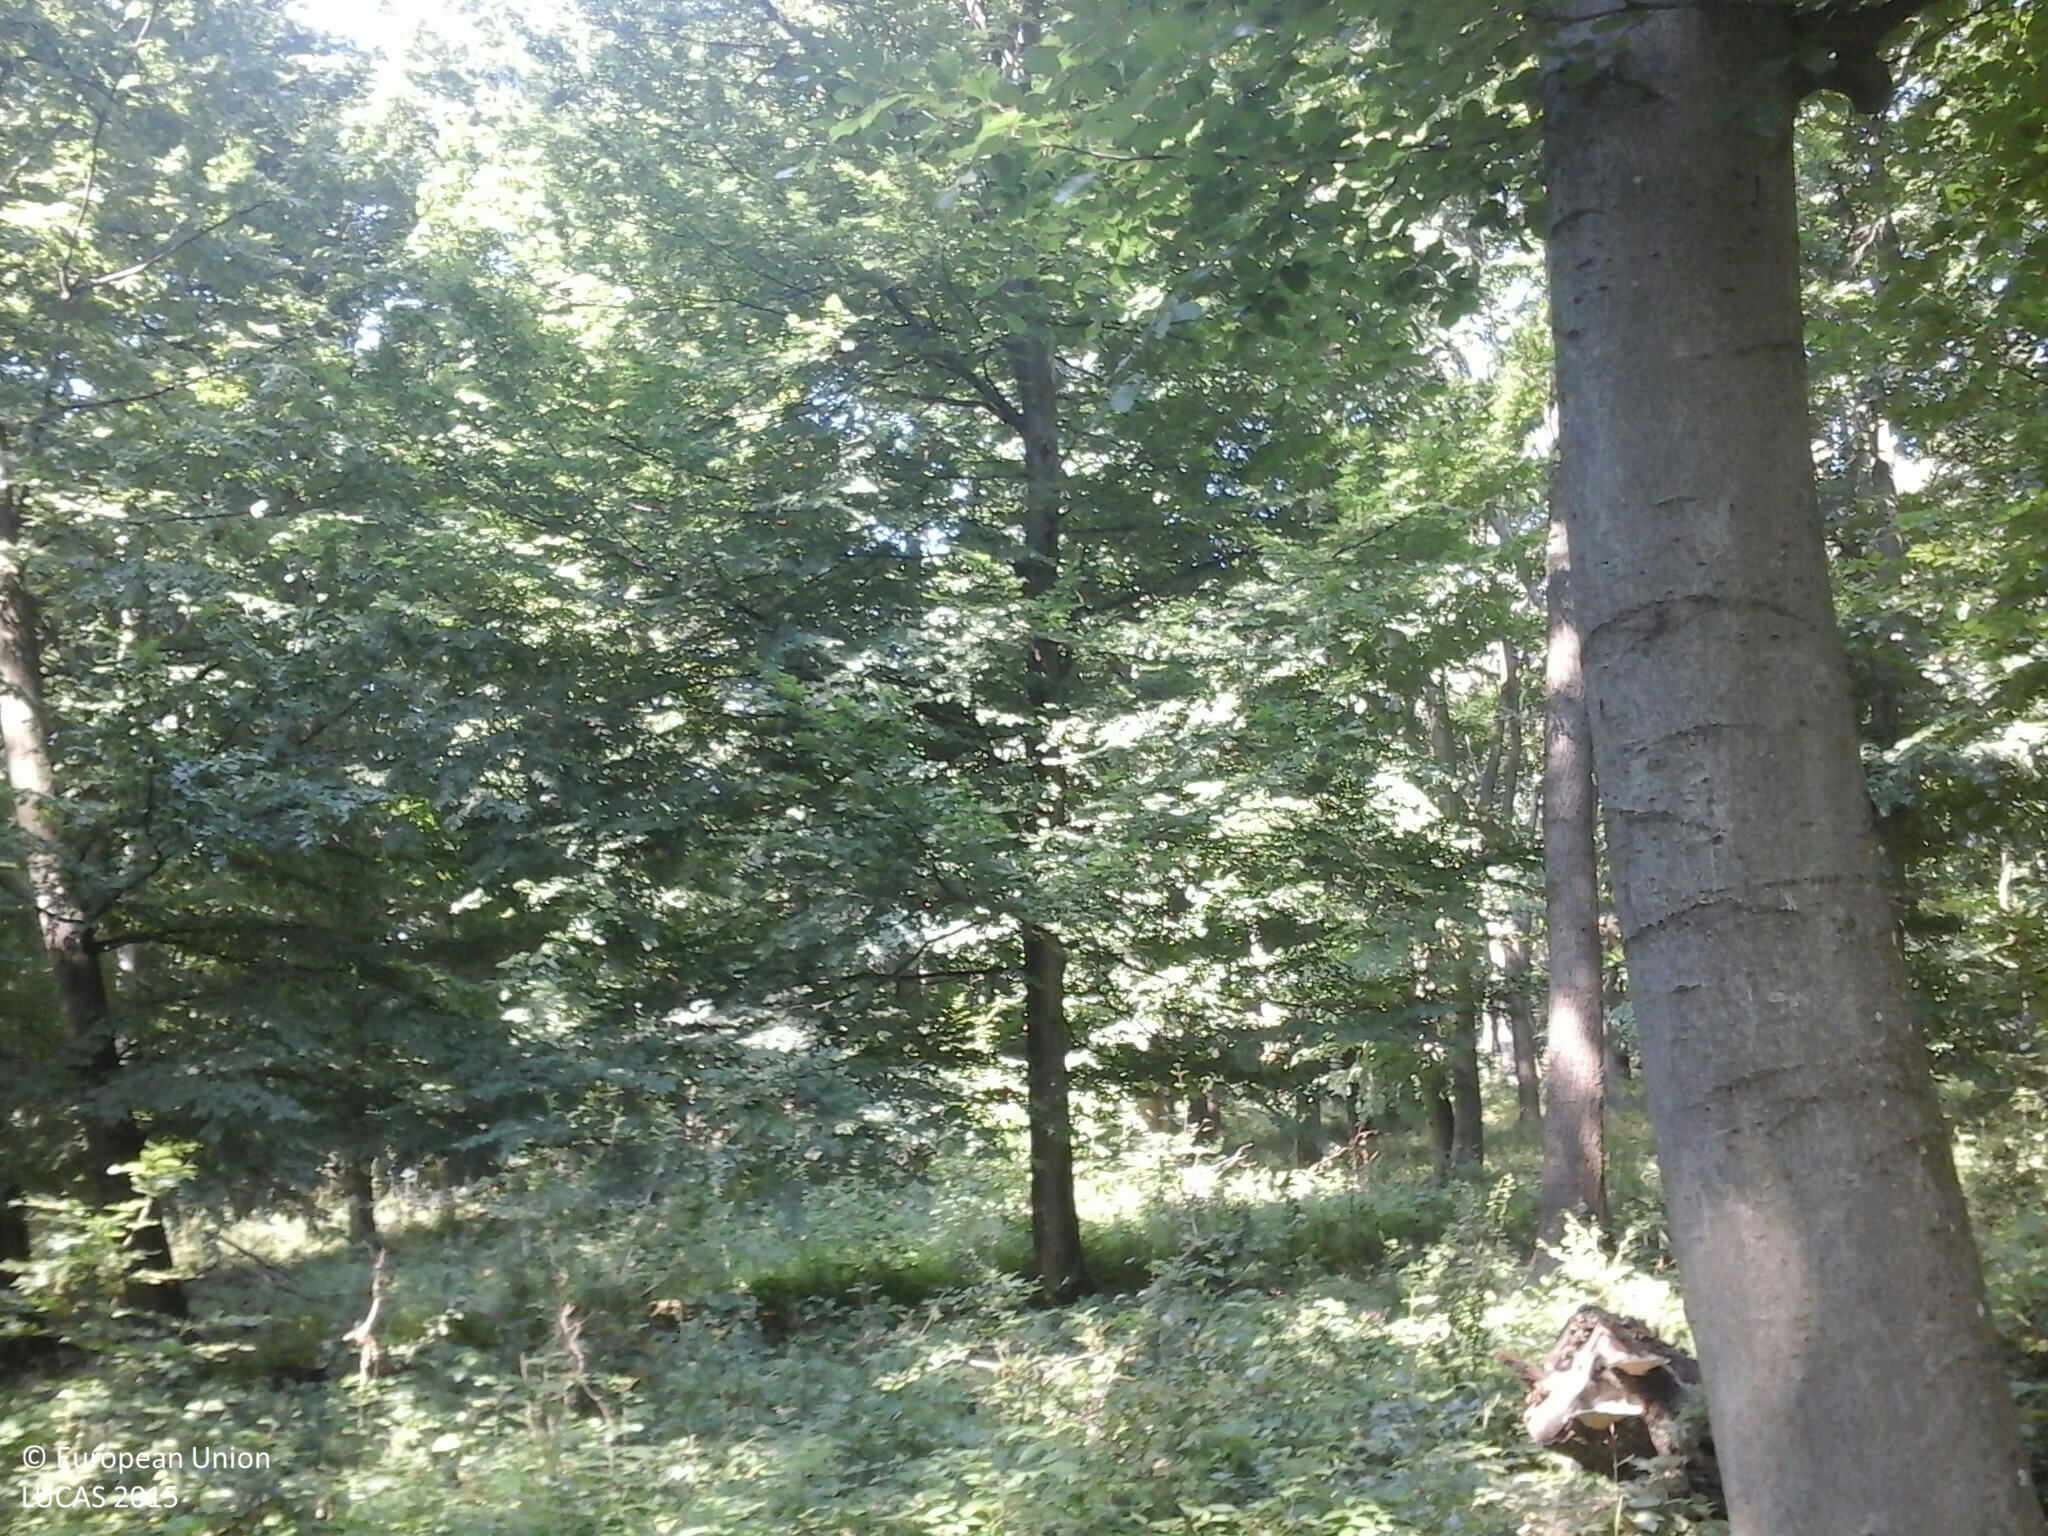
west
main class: Woodland
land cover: Broadleaved woodland
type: beech forest
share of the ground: > 75 %
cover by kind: broadleaved forest trees 95 %, herbaceous plants 5 %
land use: Forestry
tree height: > 5 m
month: July
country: HU
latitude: 47.1672
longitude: 17.8318
